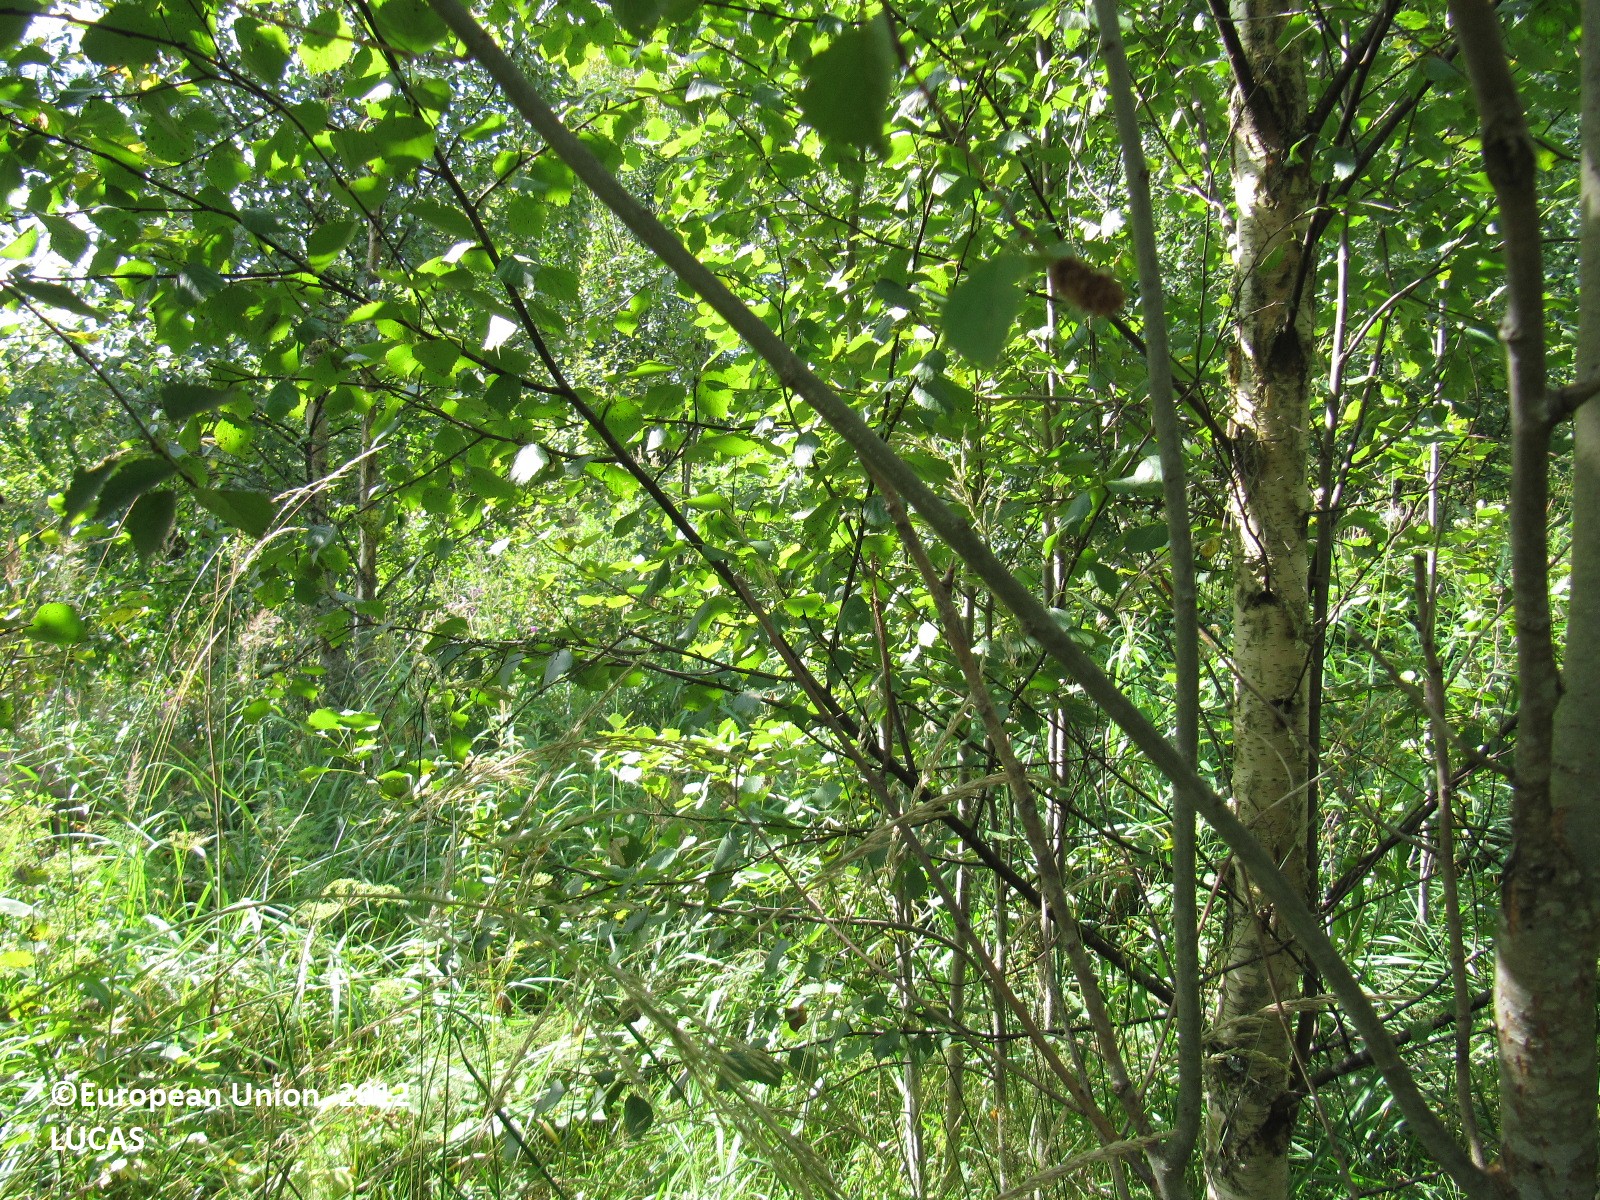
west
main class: Woodland
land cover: Broadleaved woodland
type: boreal forest
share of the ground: 50 - 75 %
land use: Forestry
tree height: > 5 m
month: August
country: FI
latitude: 60.4373
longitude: 24.4791
